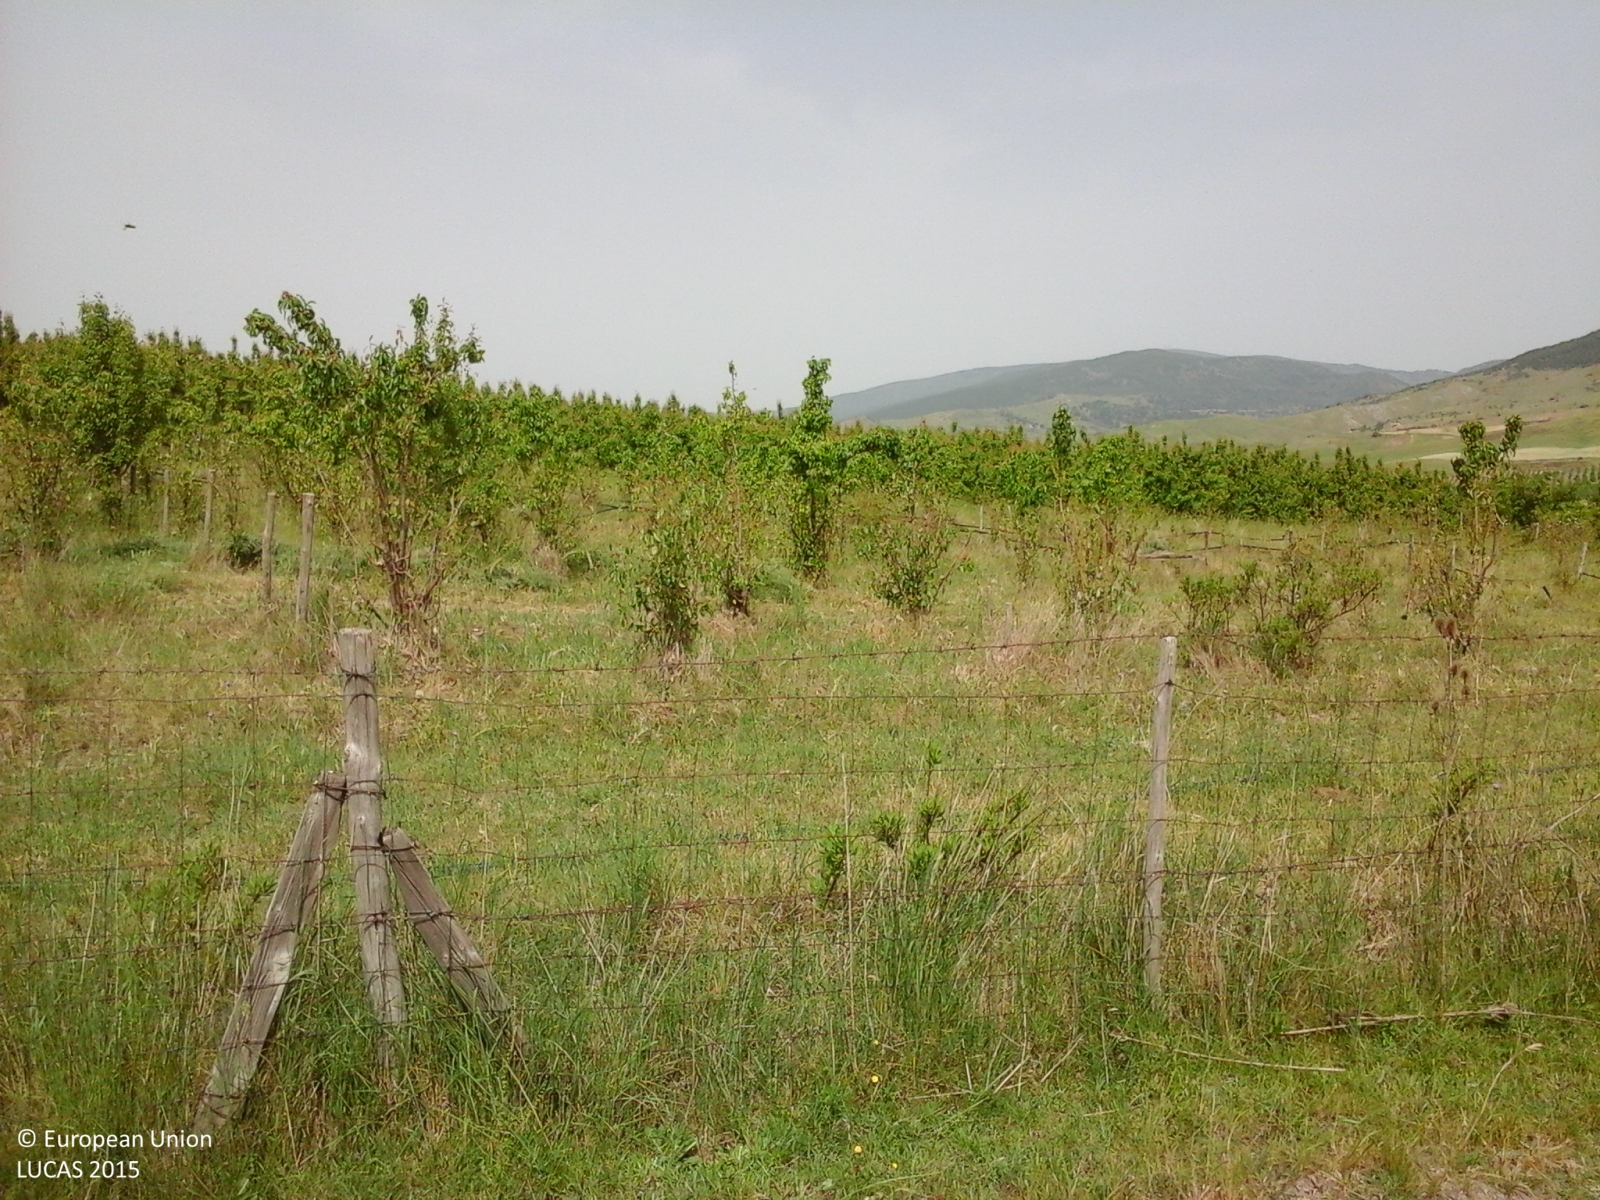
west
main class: Grassland
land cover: Grassland without tree/shrub cover
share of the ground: > 75 %
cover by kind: herbaceous plants 100 %
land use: Agriculture (excluding fallow land and kitchen gardens)
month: May
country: IT
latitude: 37.8605
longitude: 14.8430
